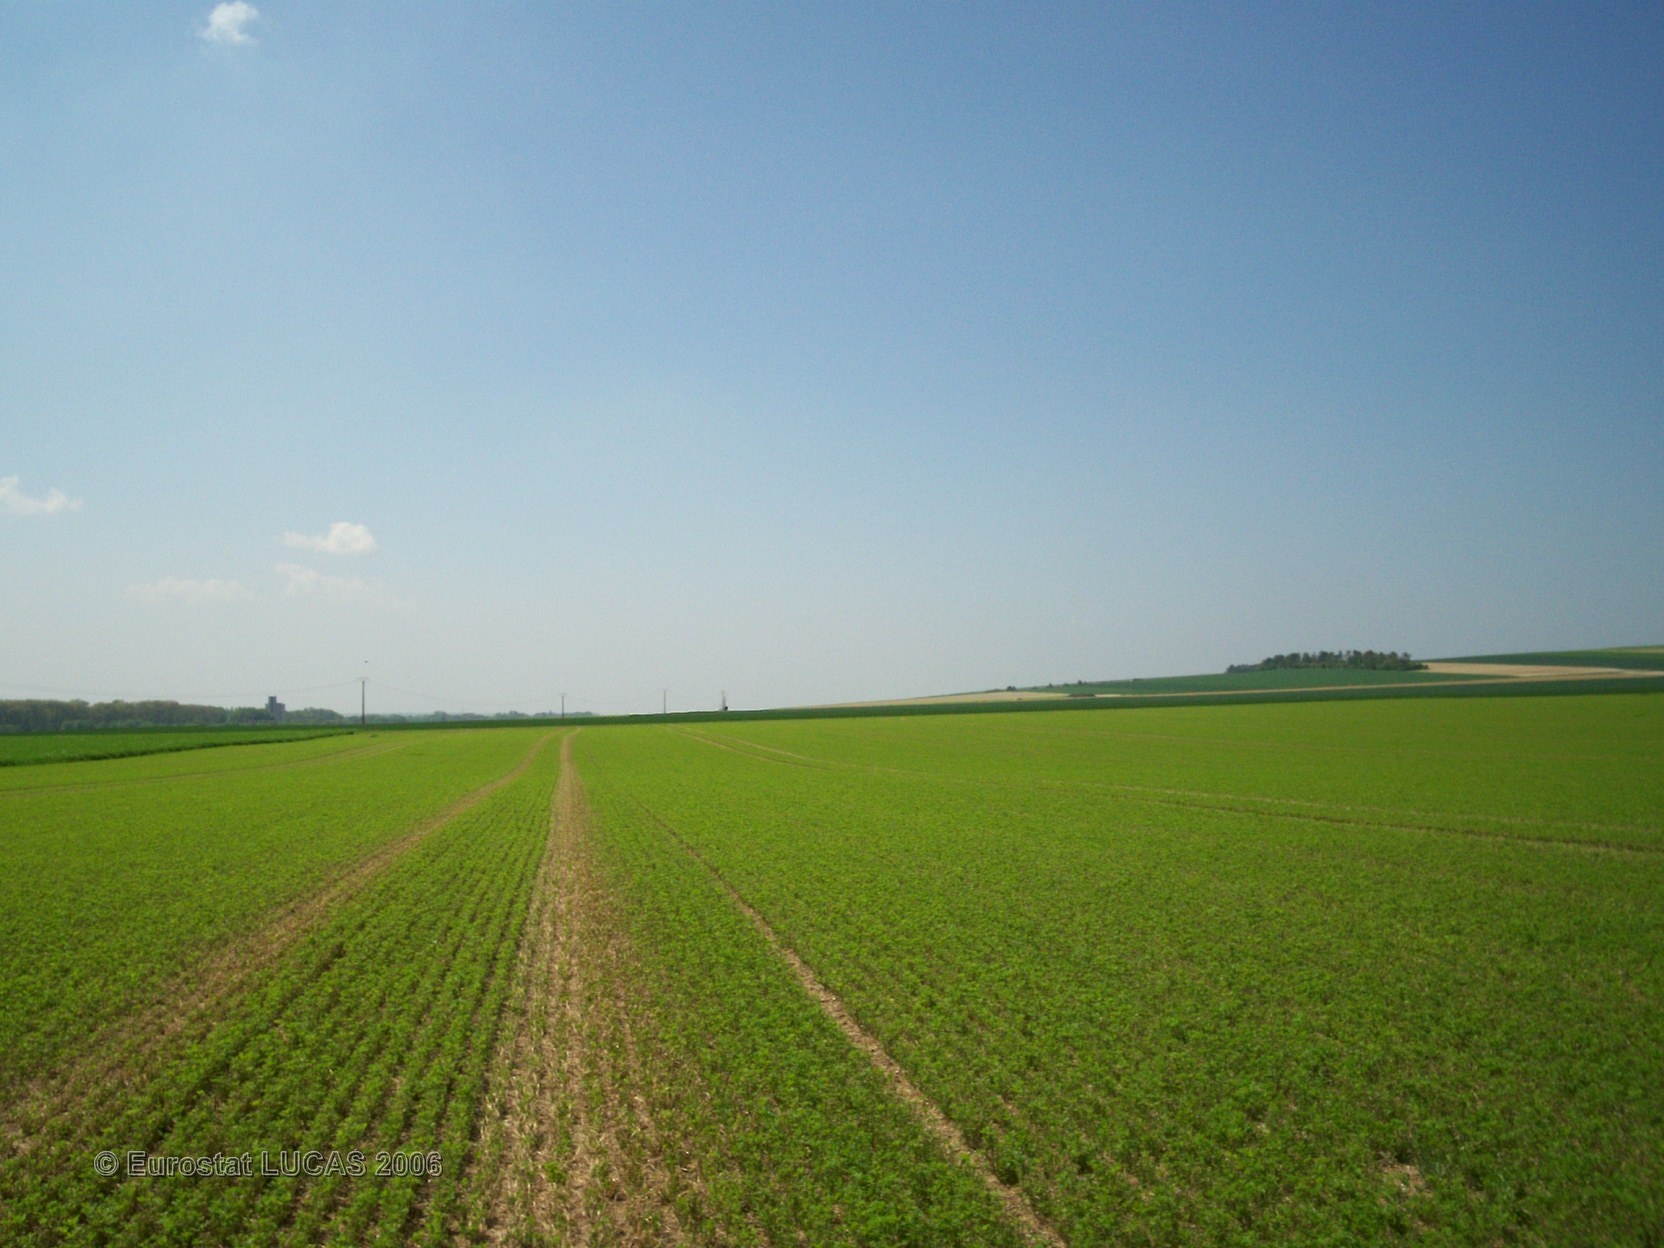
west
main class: Cropland
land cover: Lucerne
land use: Agriculture (excluding fallow land and kitchen gardens)
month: May
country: FR
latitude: 49.3047
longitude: 4.3434
